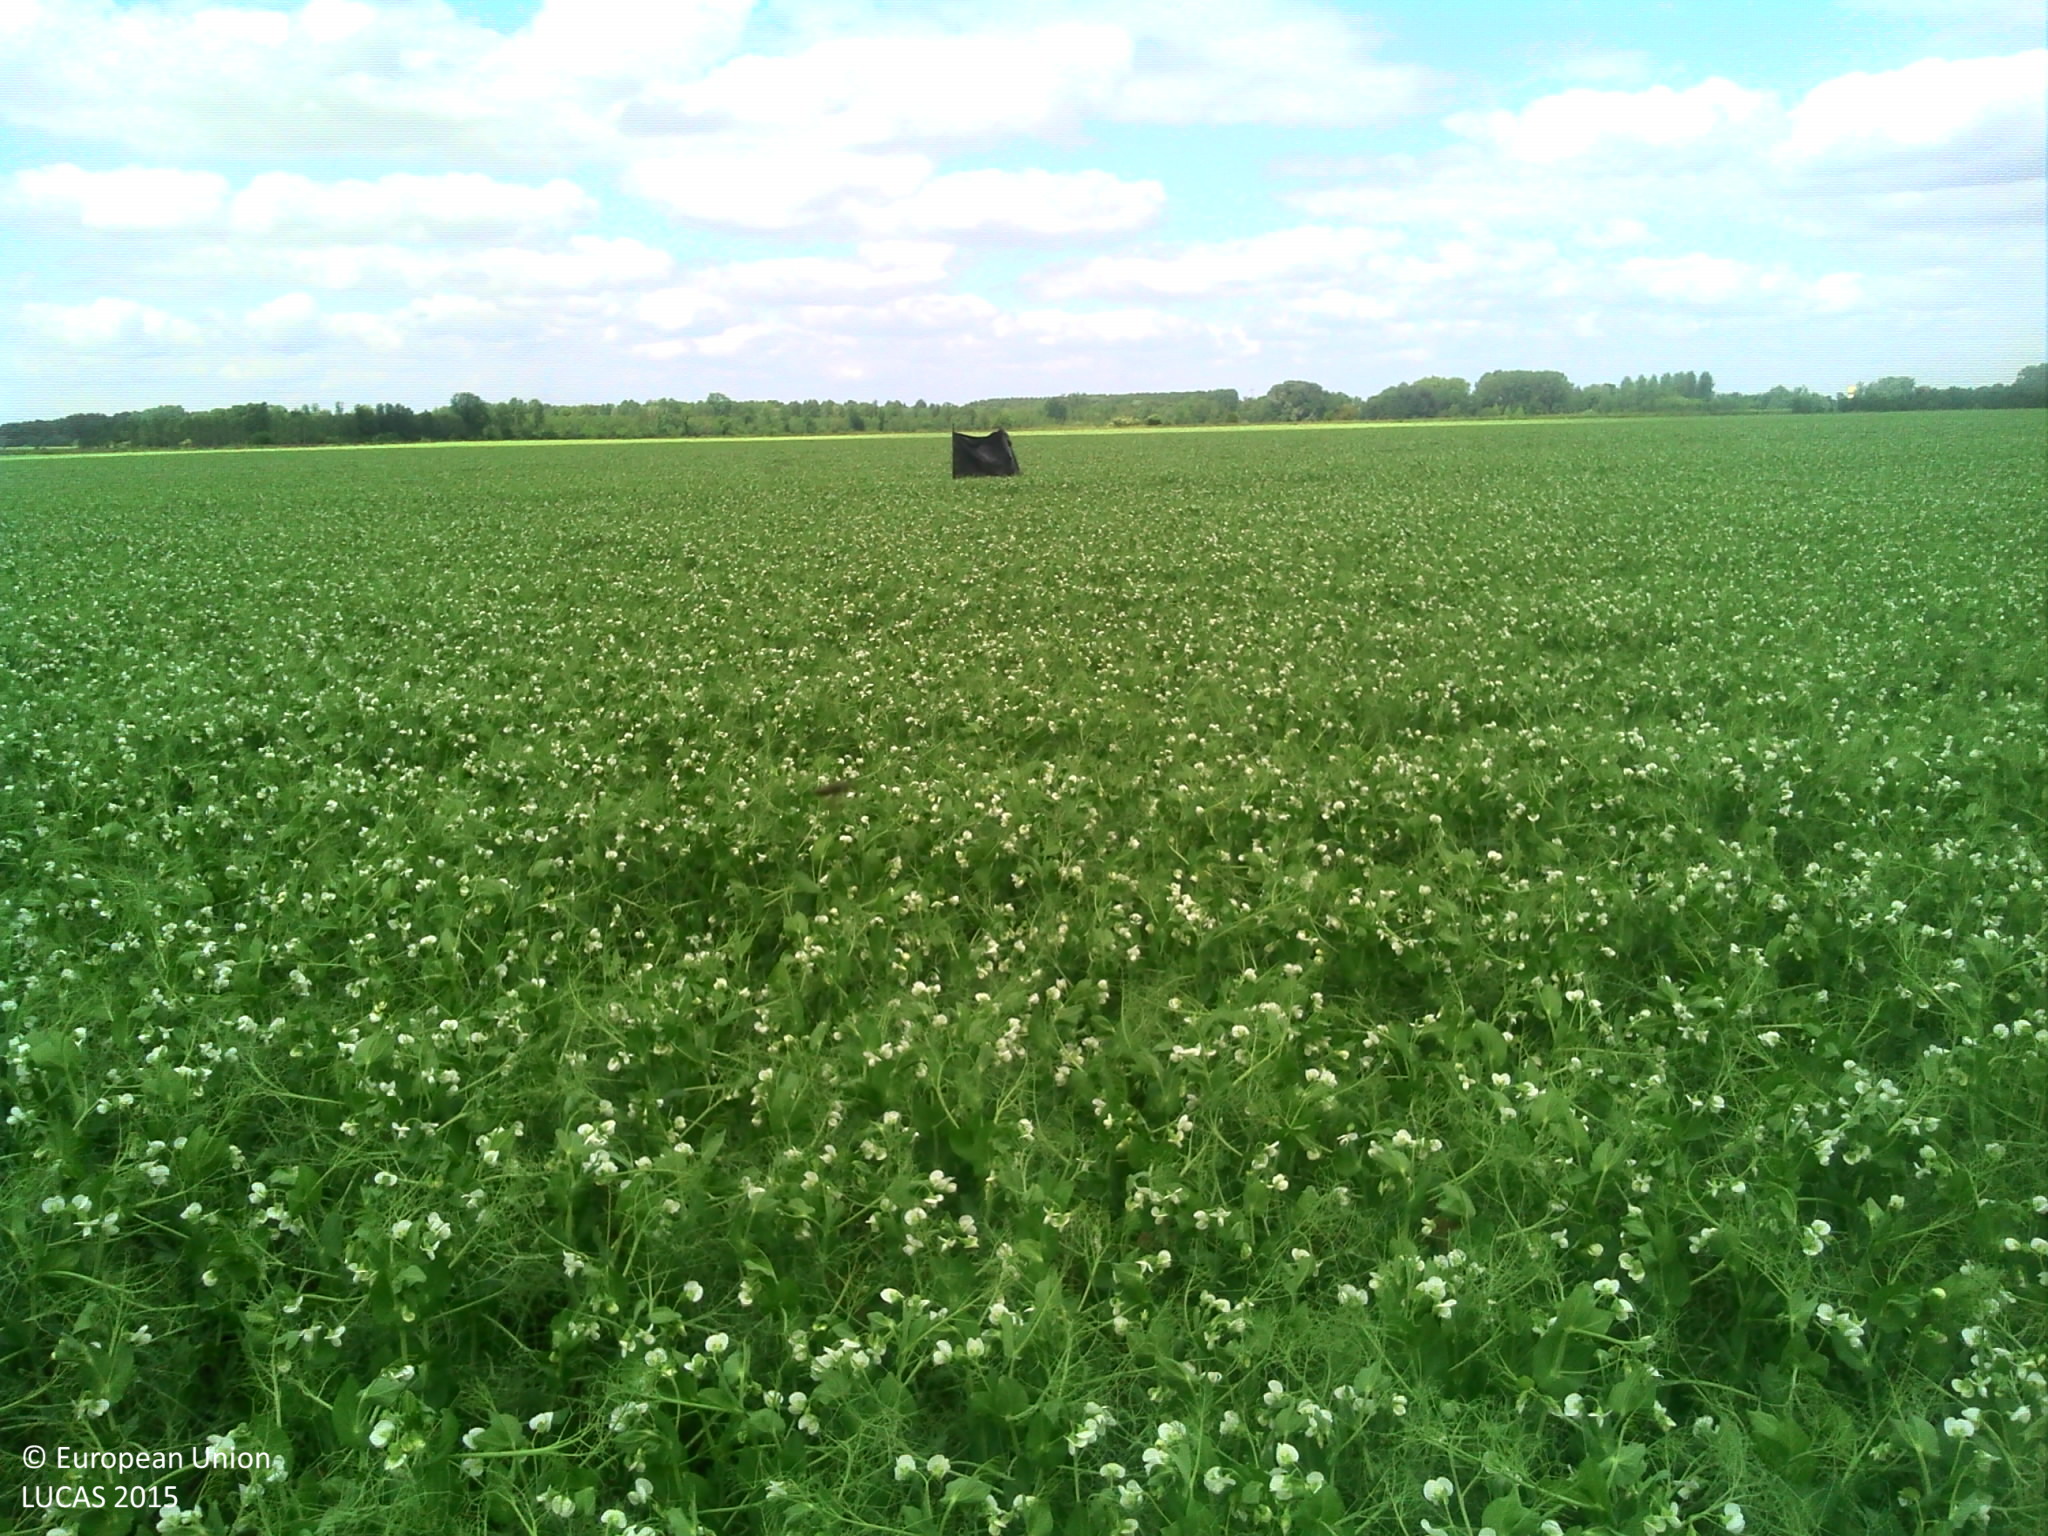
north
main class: Cropland
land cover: Dry pulses
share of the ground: > 75 %
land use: Agriculture (excluding fallow land and kitchen gardens)
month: June
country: FR
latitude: 49.7111
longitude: 3.2100
